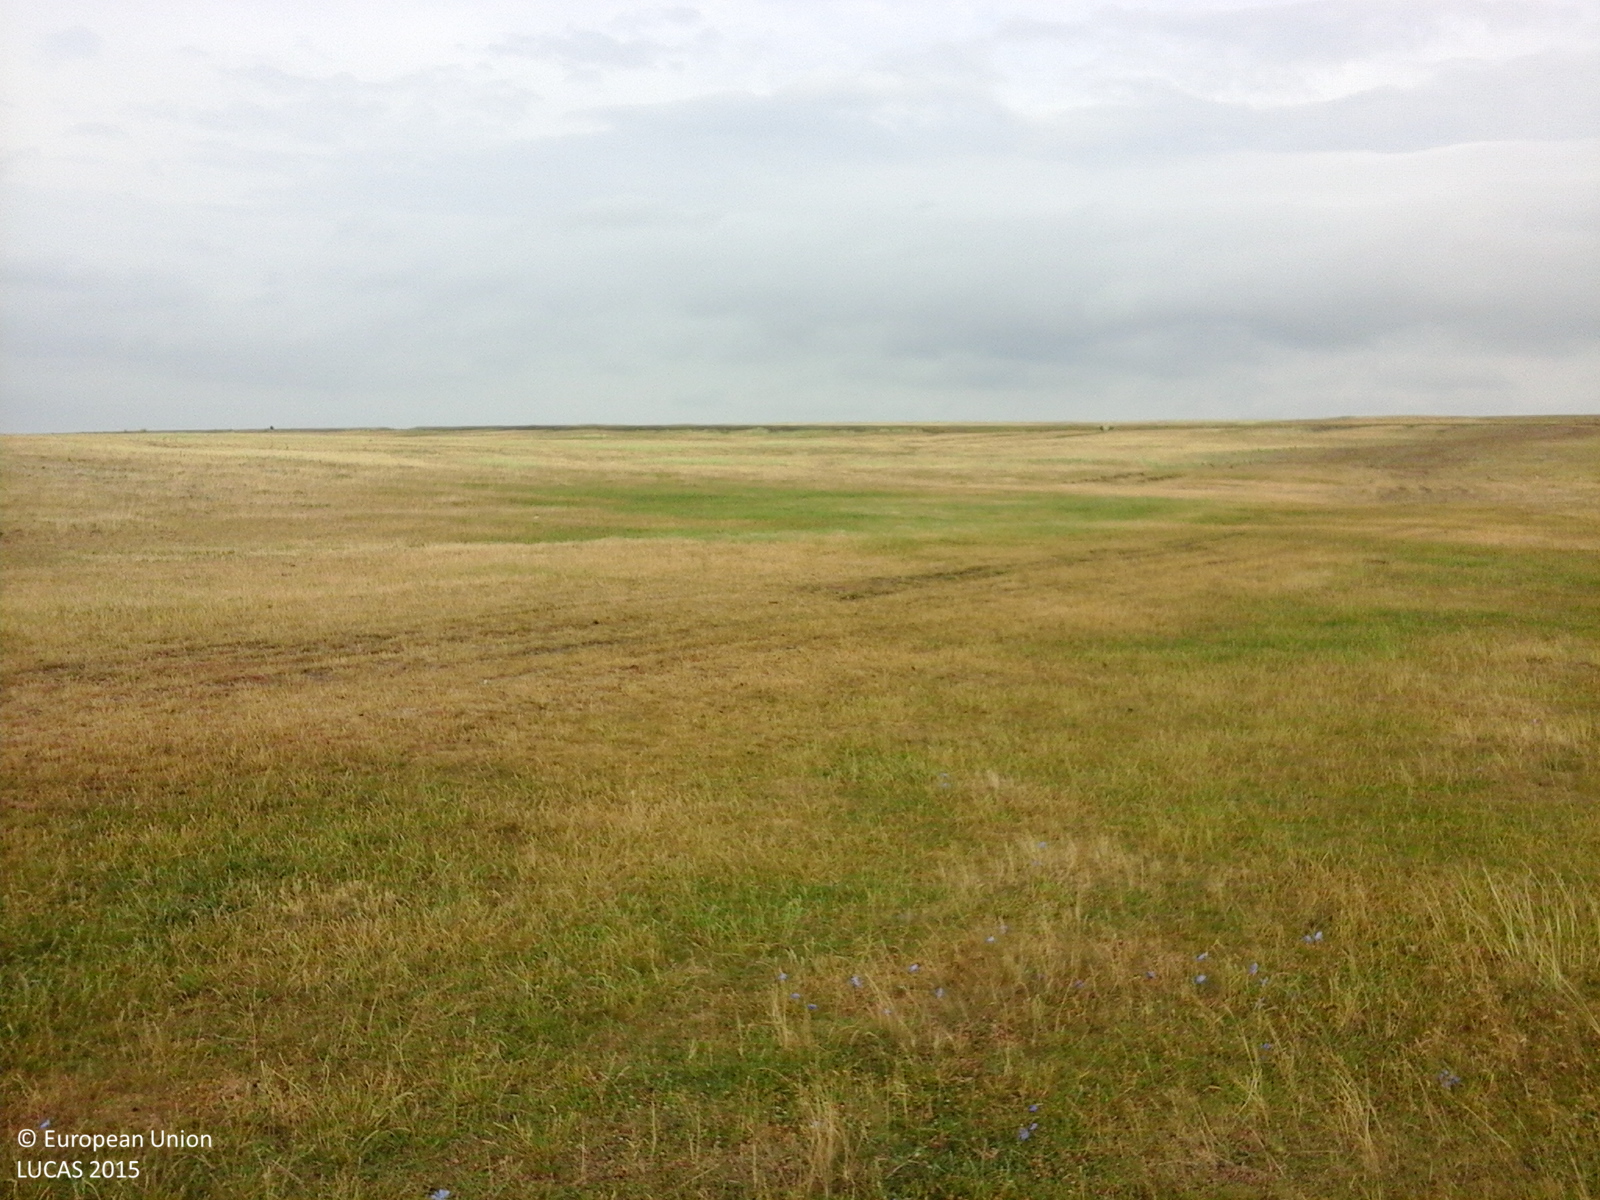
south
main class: Grassland
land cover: Grassland without tree/shrub cover
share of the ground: > 75 %
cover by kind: herbaceous plants 100 %
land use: Agriculture (excluding fallow land and kitchen gardens)
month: August
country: RO
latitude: 44.7588
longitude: 28.5859
